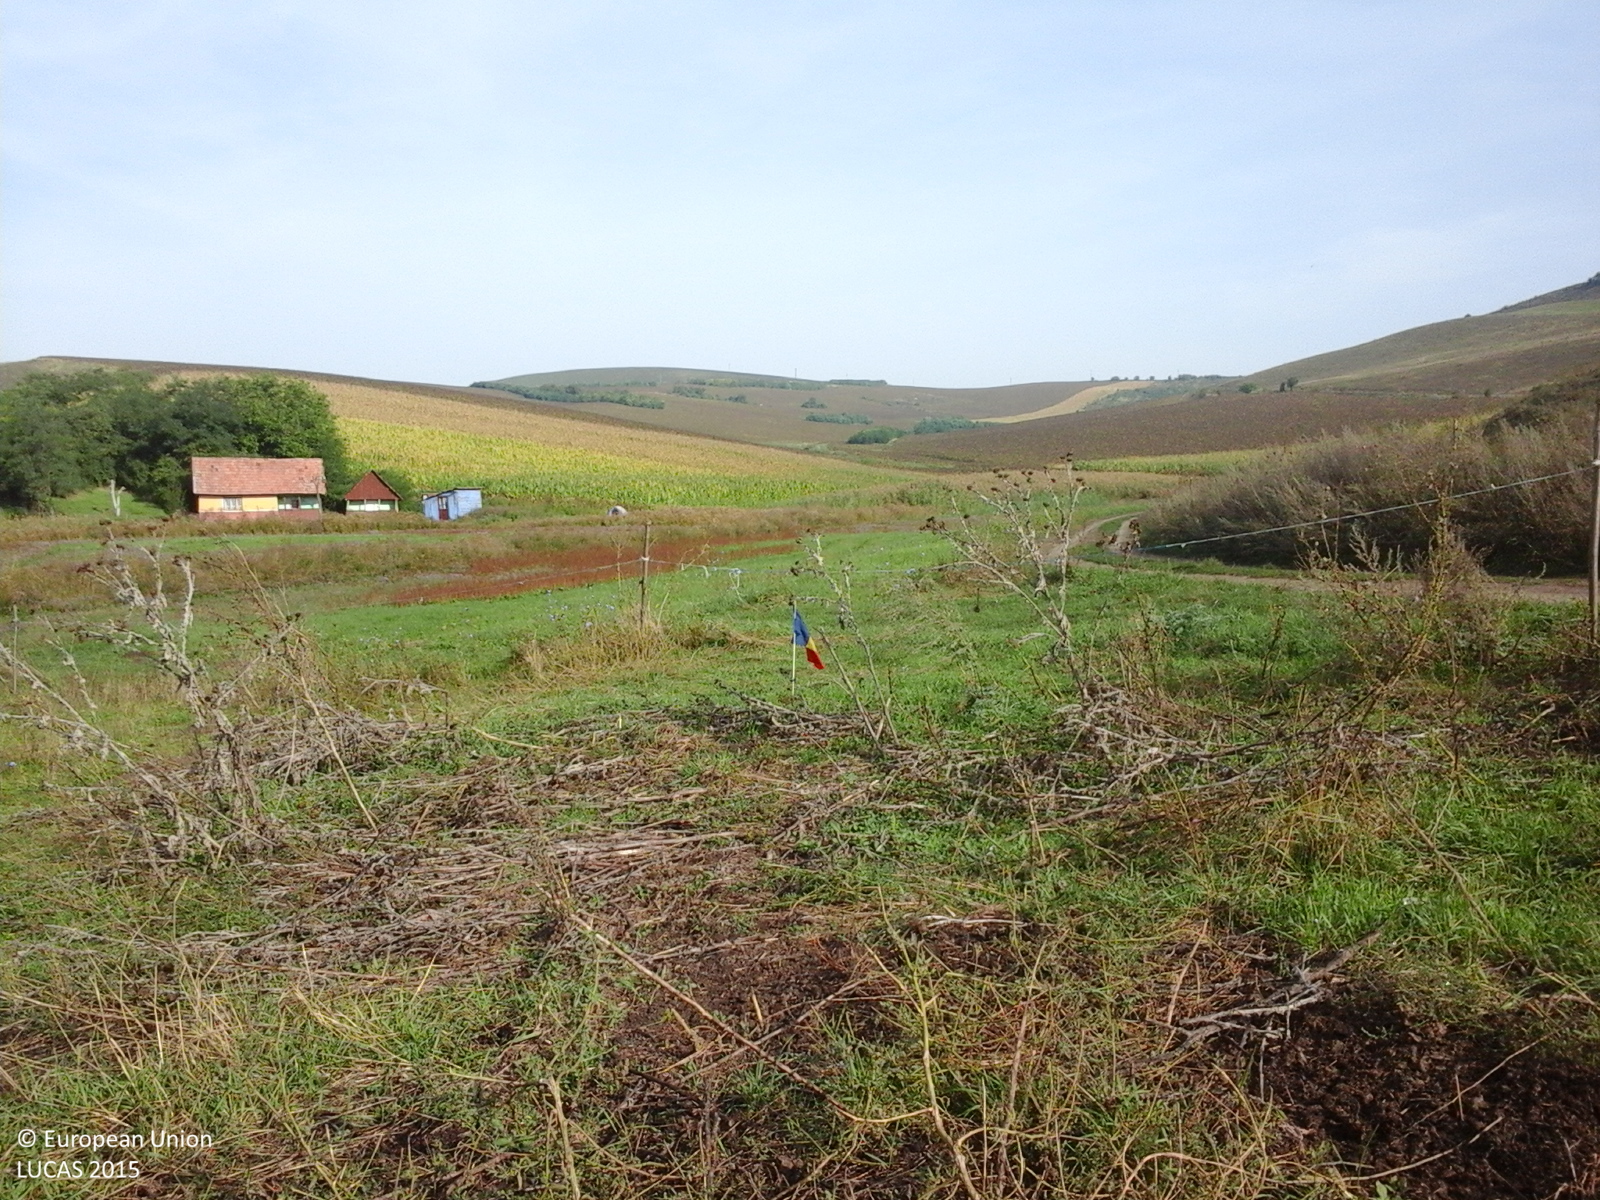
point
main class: Grassland
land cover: Grassland without tree/shrub cover
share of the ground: > 75 %
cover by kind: herbaceous plants 100 %
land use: Agriculture (excluding fallow land and kitchen gardens)
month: September
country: RO
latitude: 46.6523
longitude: 23.8340
